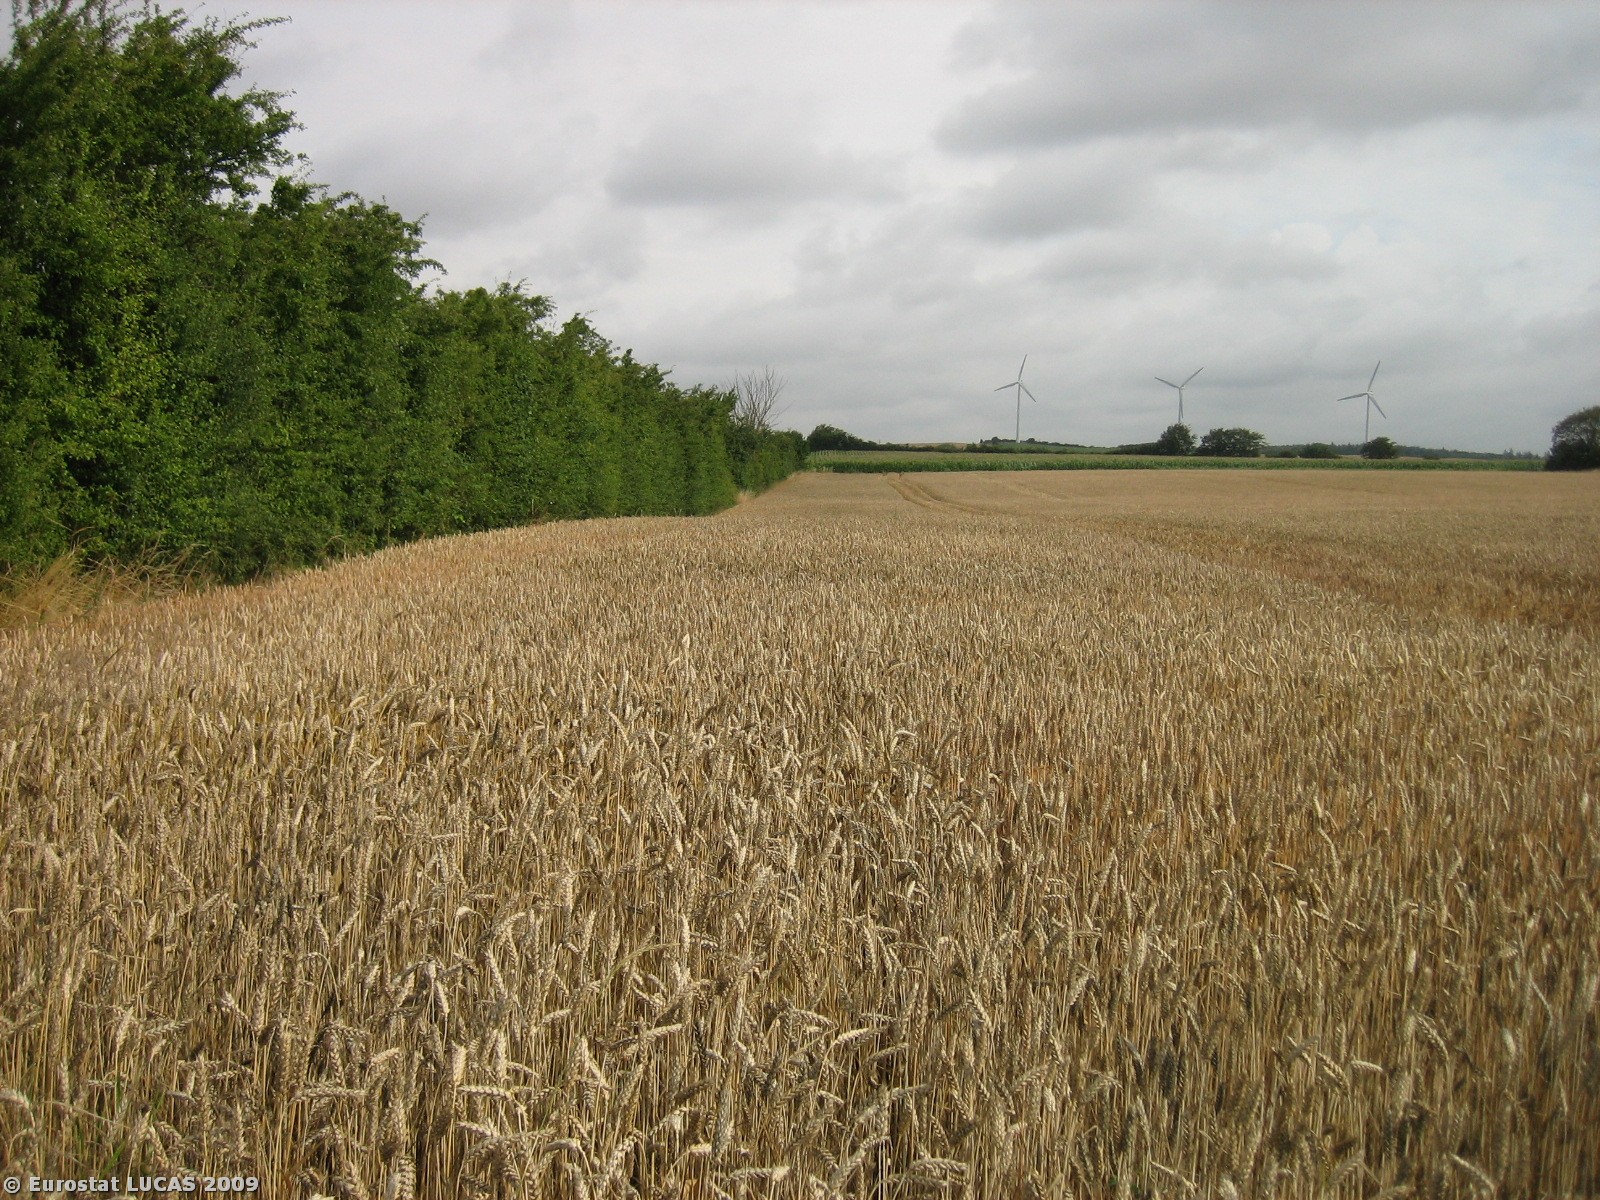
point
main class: Cropland
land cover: Common wheat
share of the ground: > 75 %
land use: Agriculture (excluding fallow land and kitchen gardens)
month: July
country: DK
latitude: 55.2171
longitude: 10.0471
